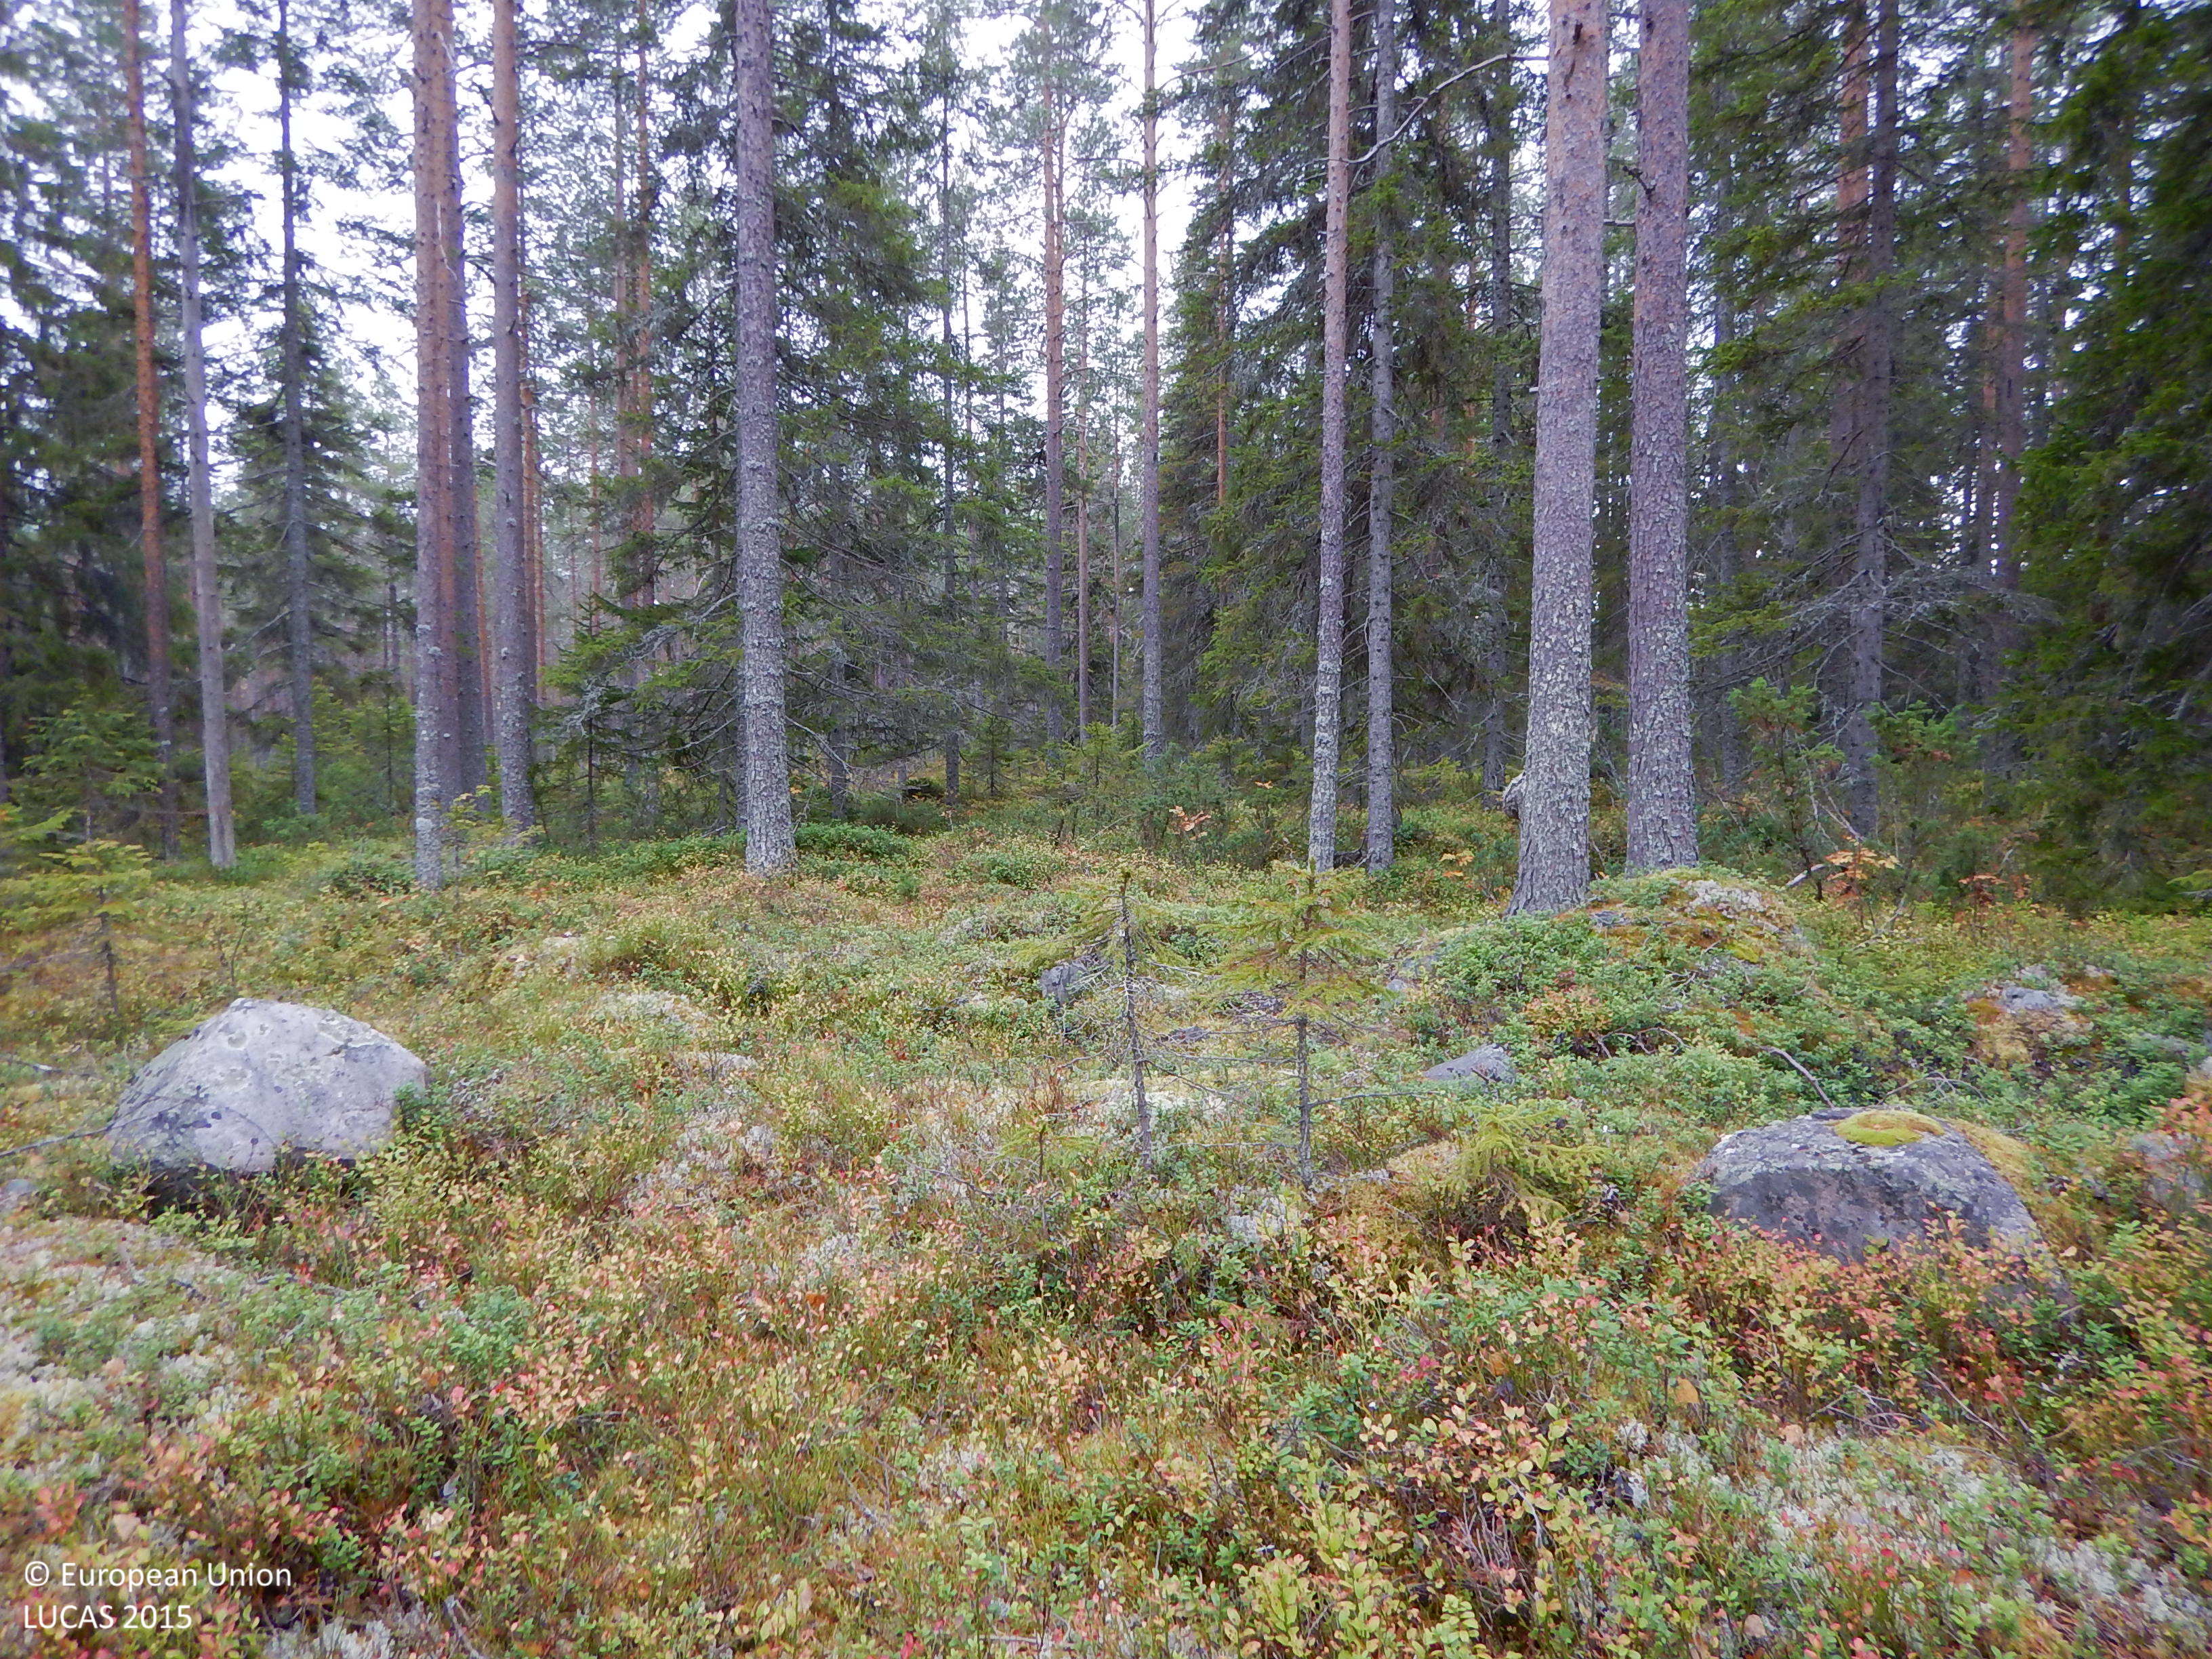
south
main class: Woodland
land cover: Pine dominated coniferous woodland
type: boreal forest
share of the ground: 50 - 75 %
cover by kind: coniferous forest trees 65 %, shrubs 15 %, lichens and mosses 15 %, herbaceous plants 5 %
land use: Forestry
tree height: > 5 m
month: October
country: SE
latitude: 64.9616
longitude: 21.0517
